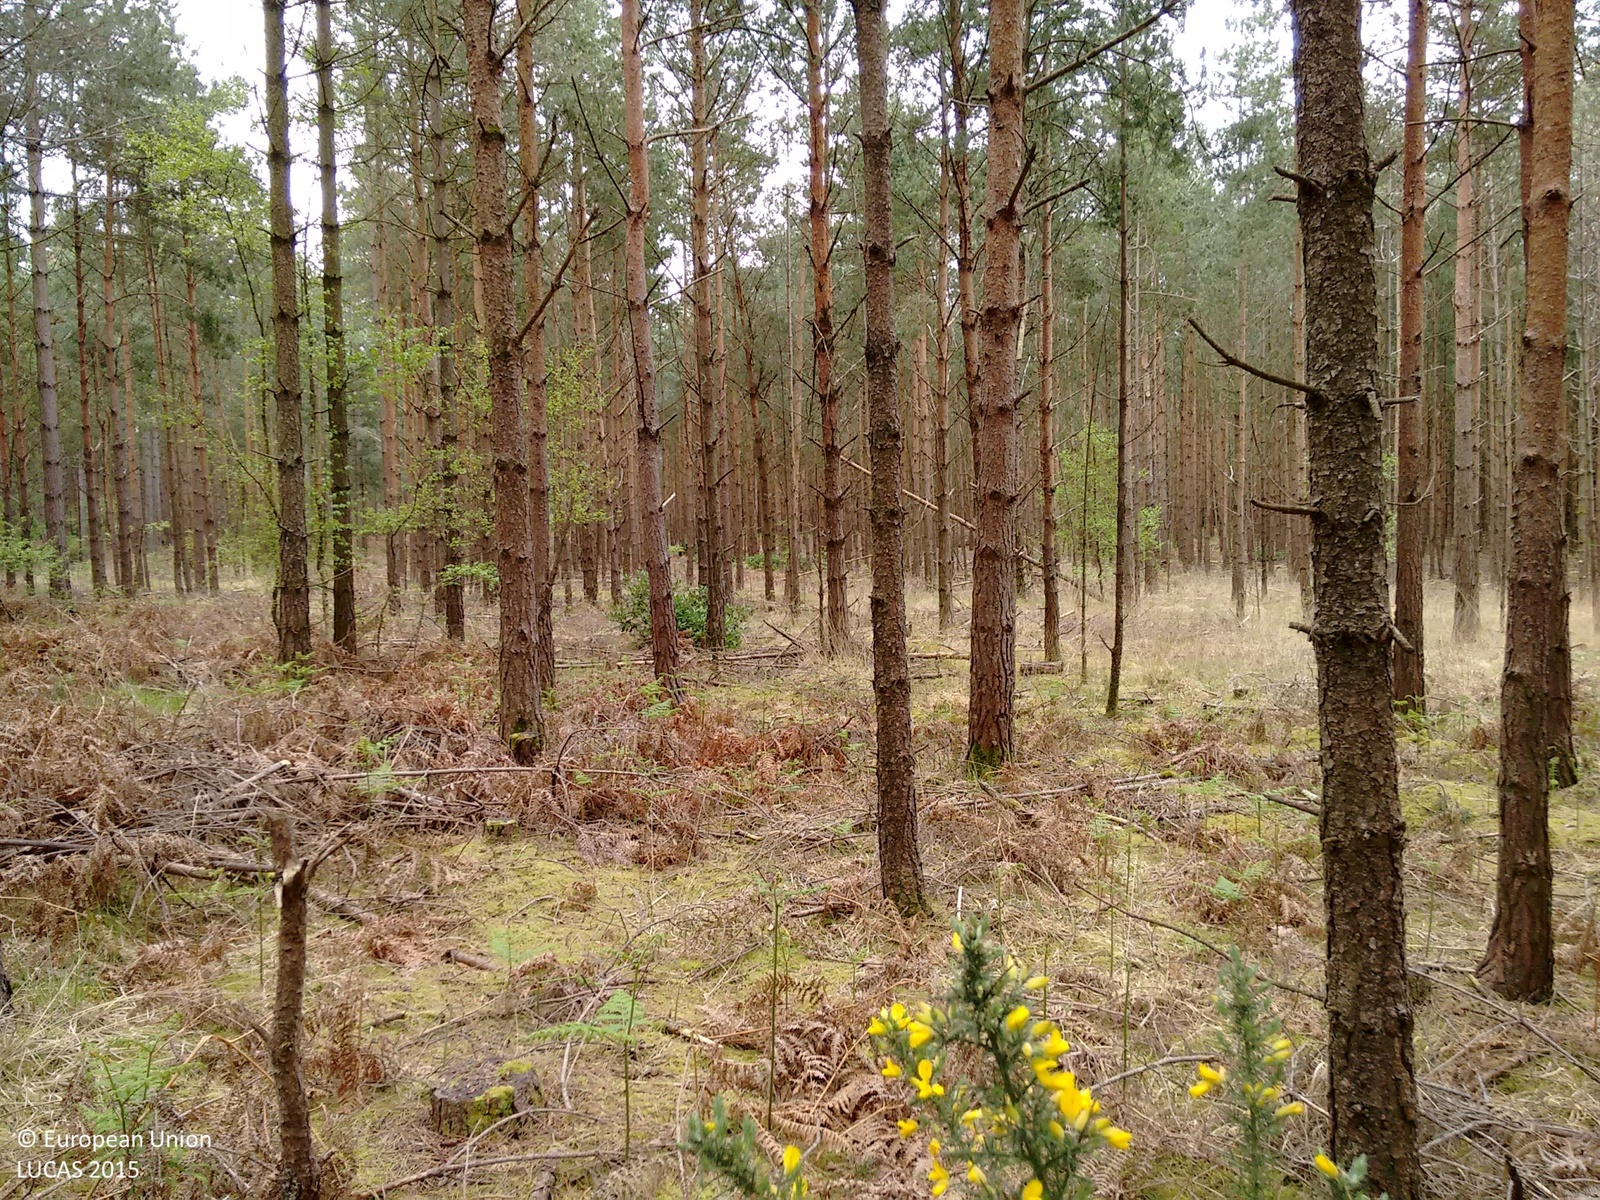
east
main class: Woodland
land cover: Pine dominated coniferous woodland
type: hemiboreal forest and nemoral coniferous forest and mixed broadleaved-coniferous forest
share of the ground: > 75 %
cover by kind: coniferous forest trees 100 %
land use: Forestry
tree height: > 5 m
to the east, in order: Pine dominated coniferous woodland; Tracks; Pine dominated coniferous woodland
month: May
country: GB
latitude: 50.8002
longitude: -1.8467
